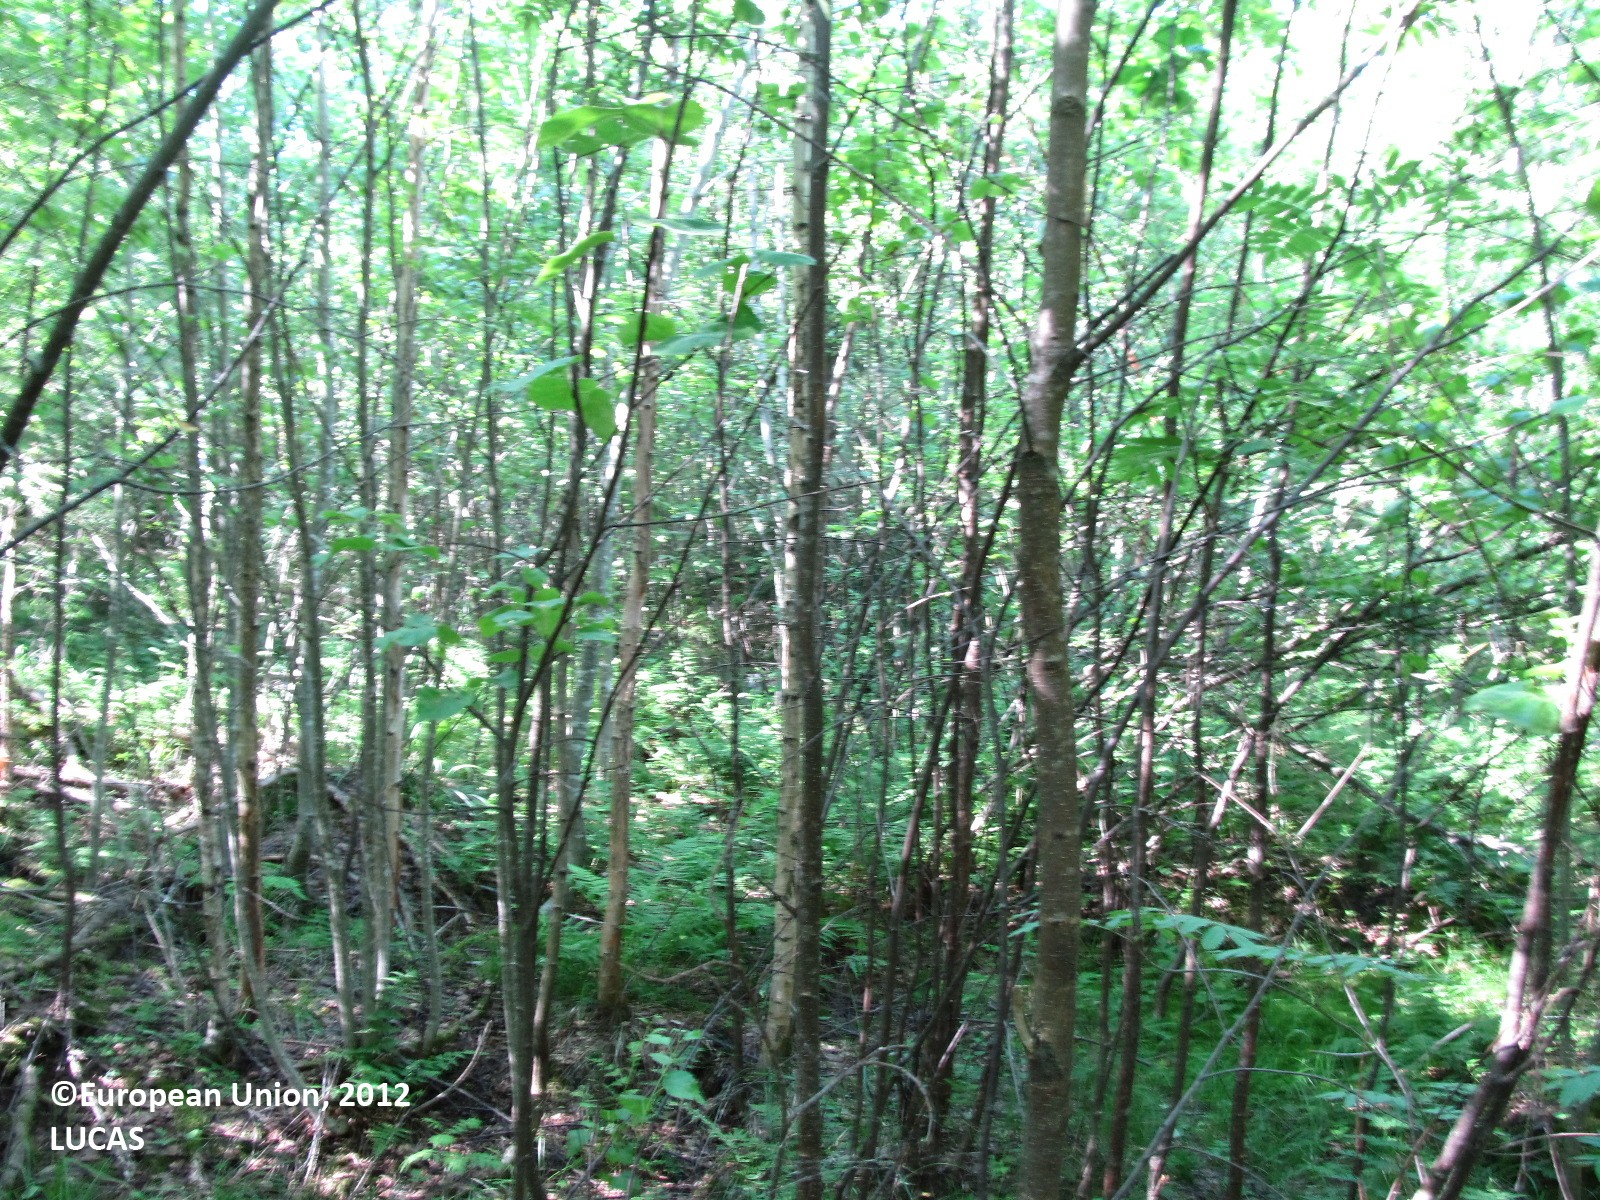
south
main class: Woodland
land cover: Broadleaved woodland
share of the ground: > 75 %
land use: Forestry
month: July
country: FI
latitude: 62.2091
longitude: 29.2469
